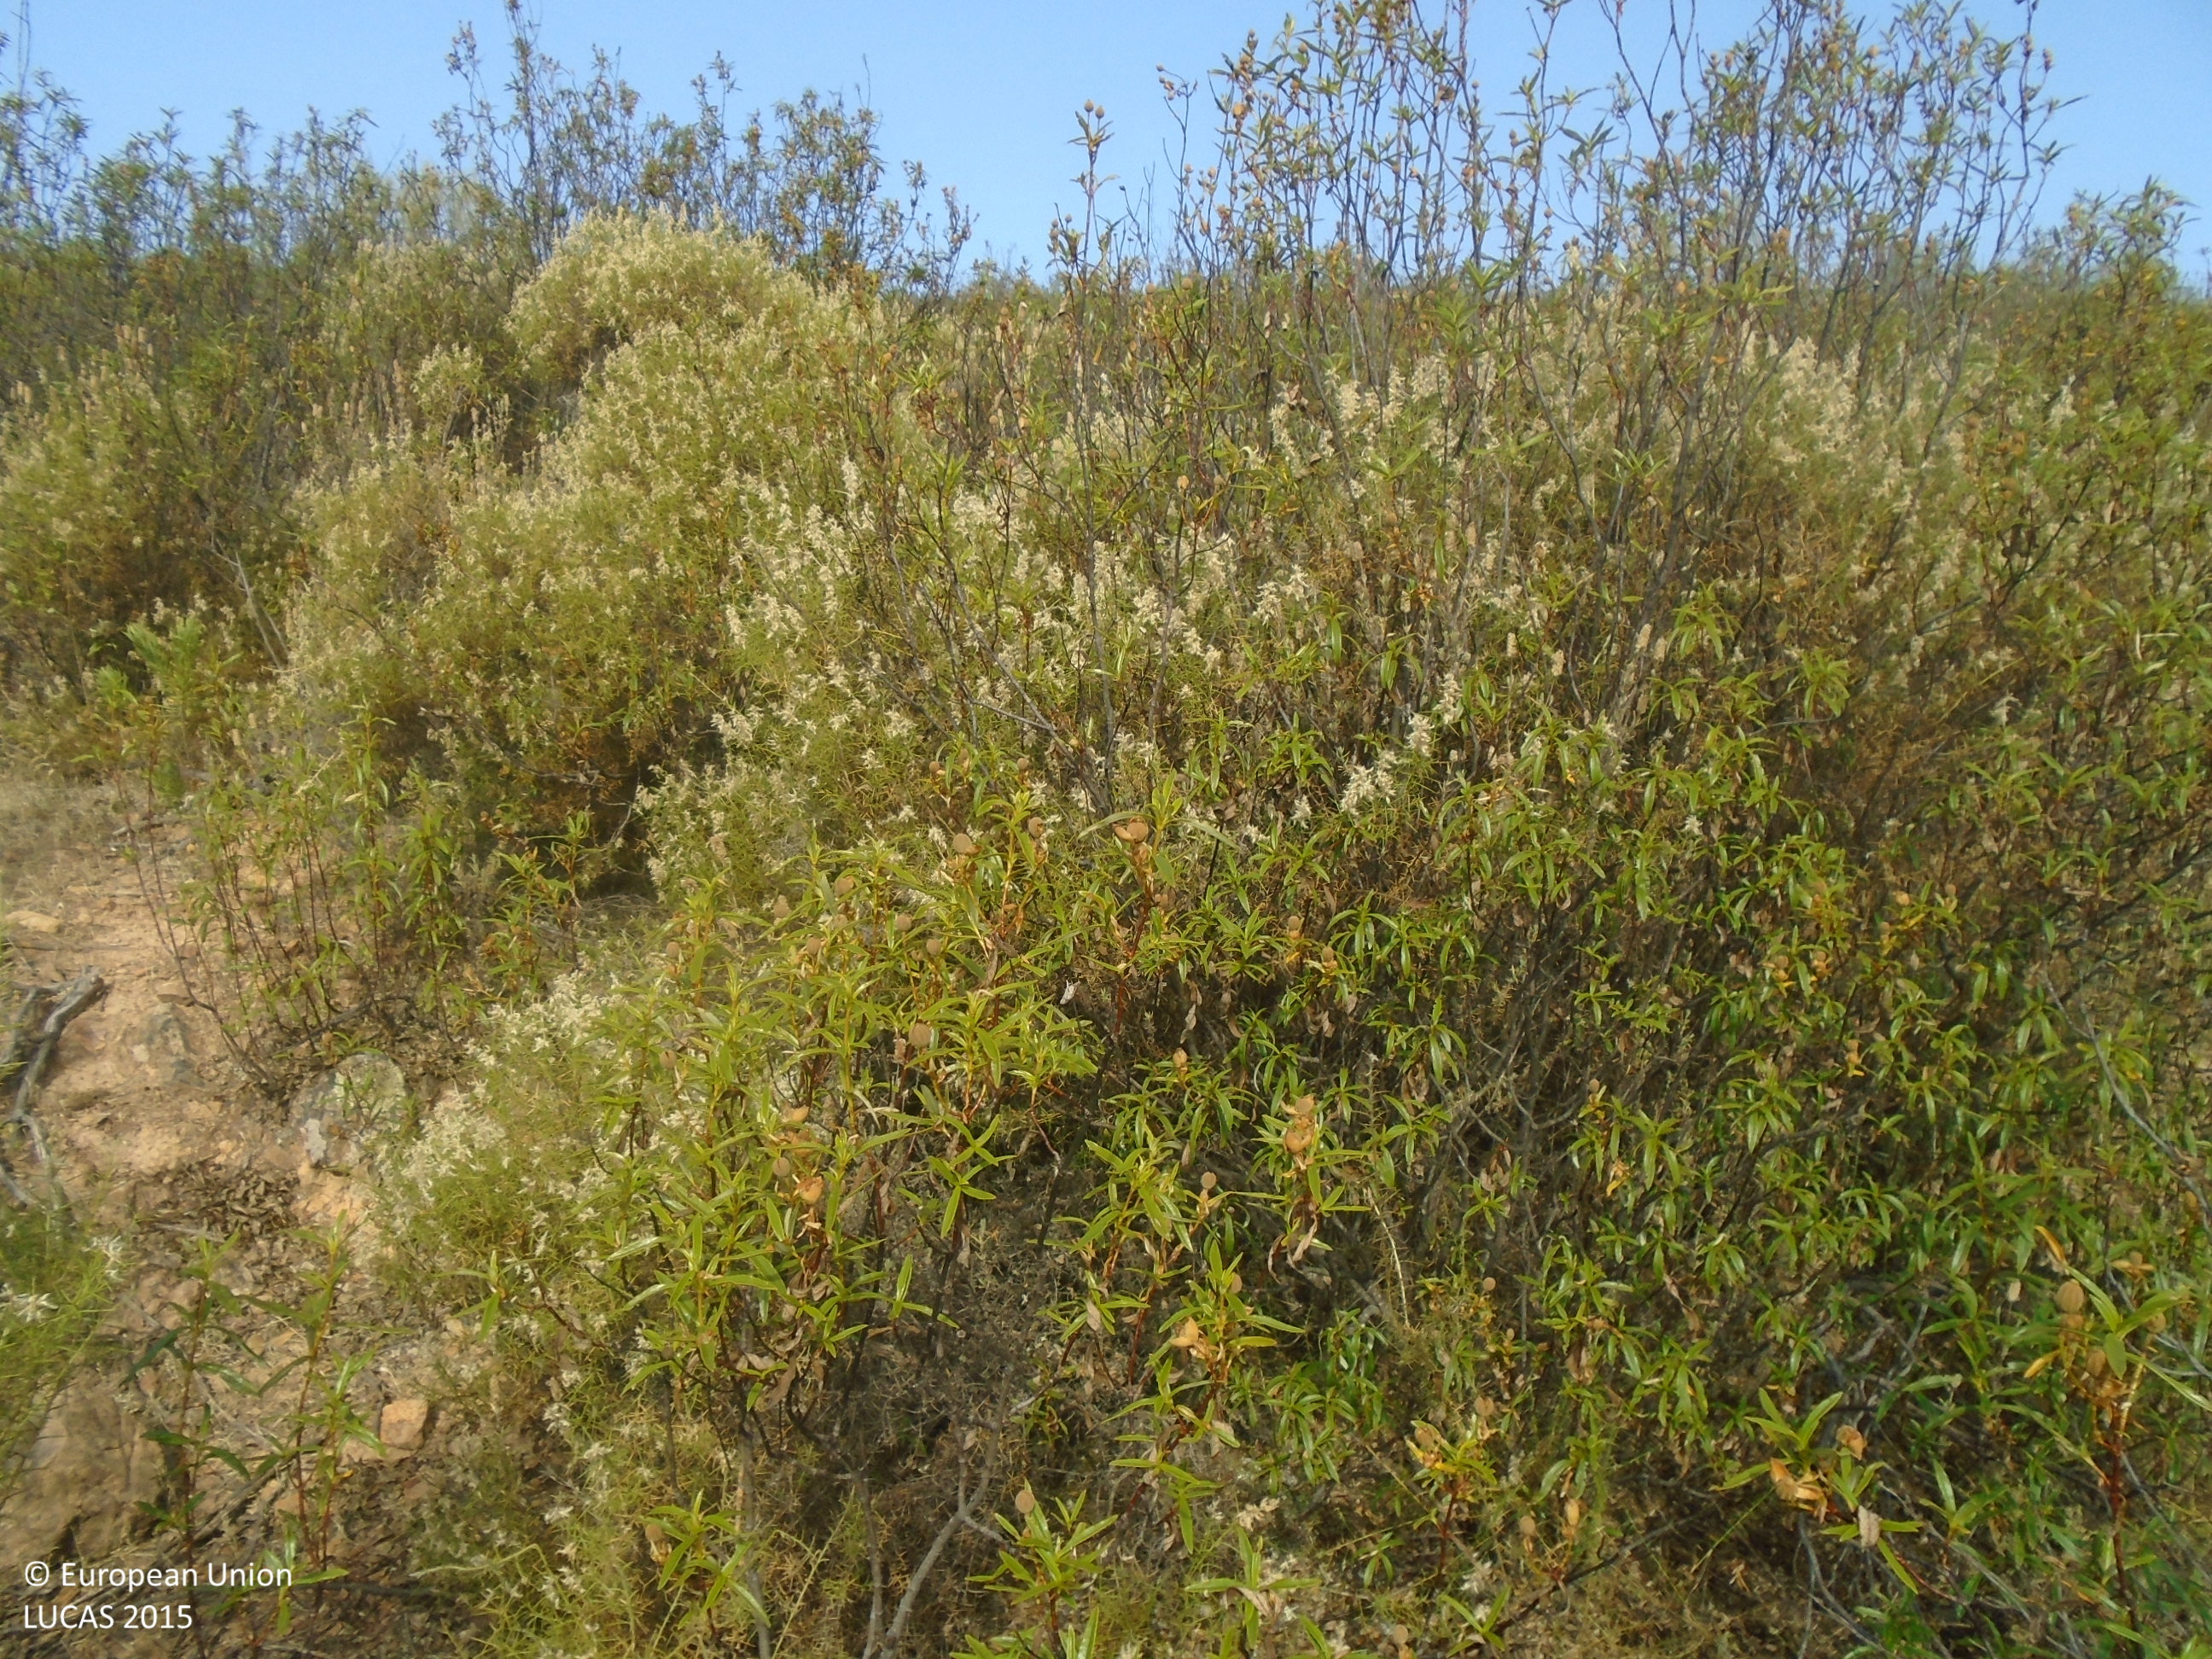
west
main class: Shrubland
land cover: Shrubland without tree cover
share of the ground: > 75 %
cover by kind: shrubs 90 %, herbaceous plants 10 %
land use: Semi-natural and natural areas not in use
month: July
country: ES
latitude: 39.2030
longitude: -4.4945
